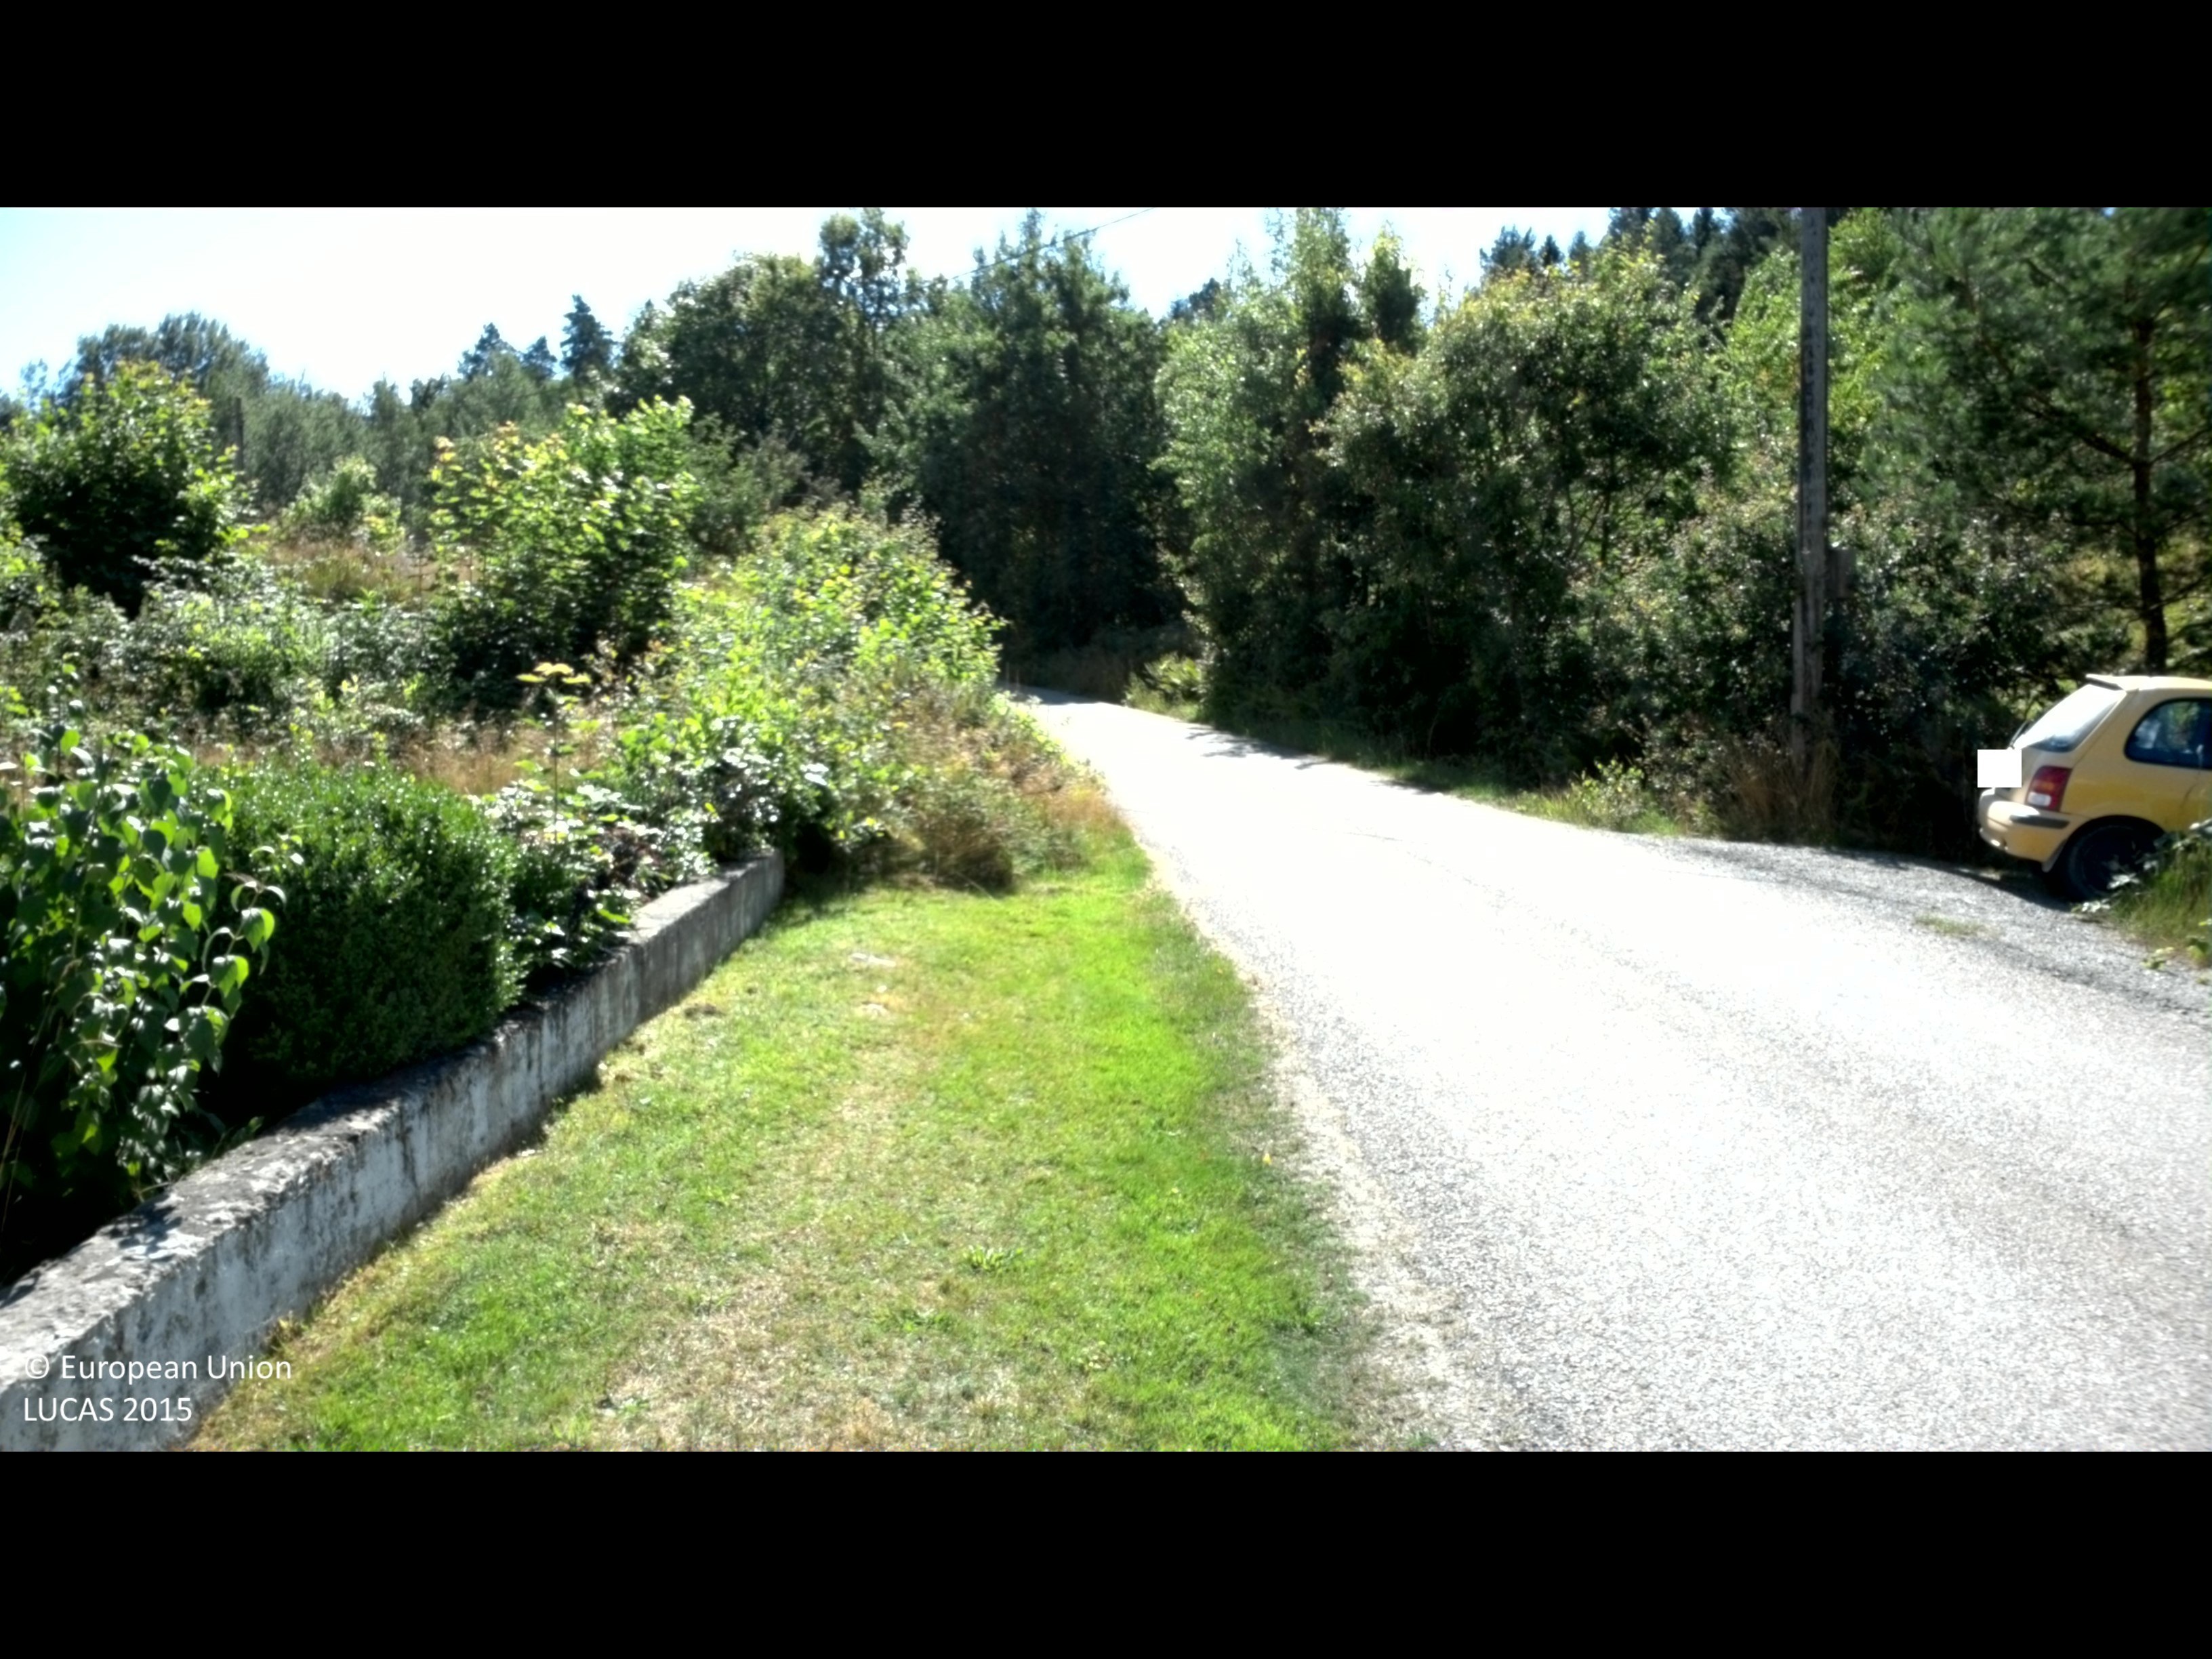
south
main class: Grassland
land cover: Grassland without tree/shrub cover
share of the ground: > 75 %
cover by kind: herbaceous plants 100 %
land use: Residential
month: August
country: SE
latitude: 56.2425
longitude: 14.7907
